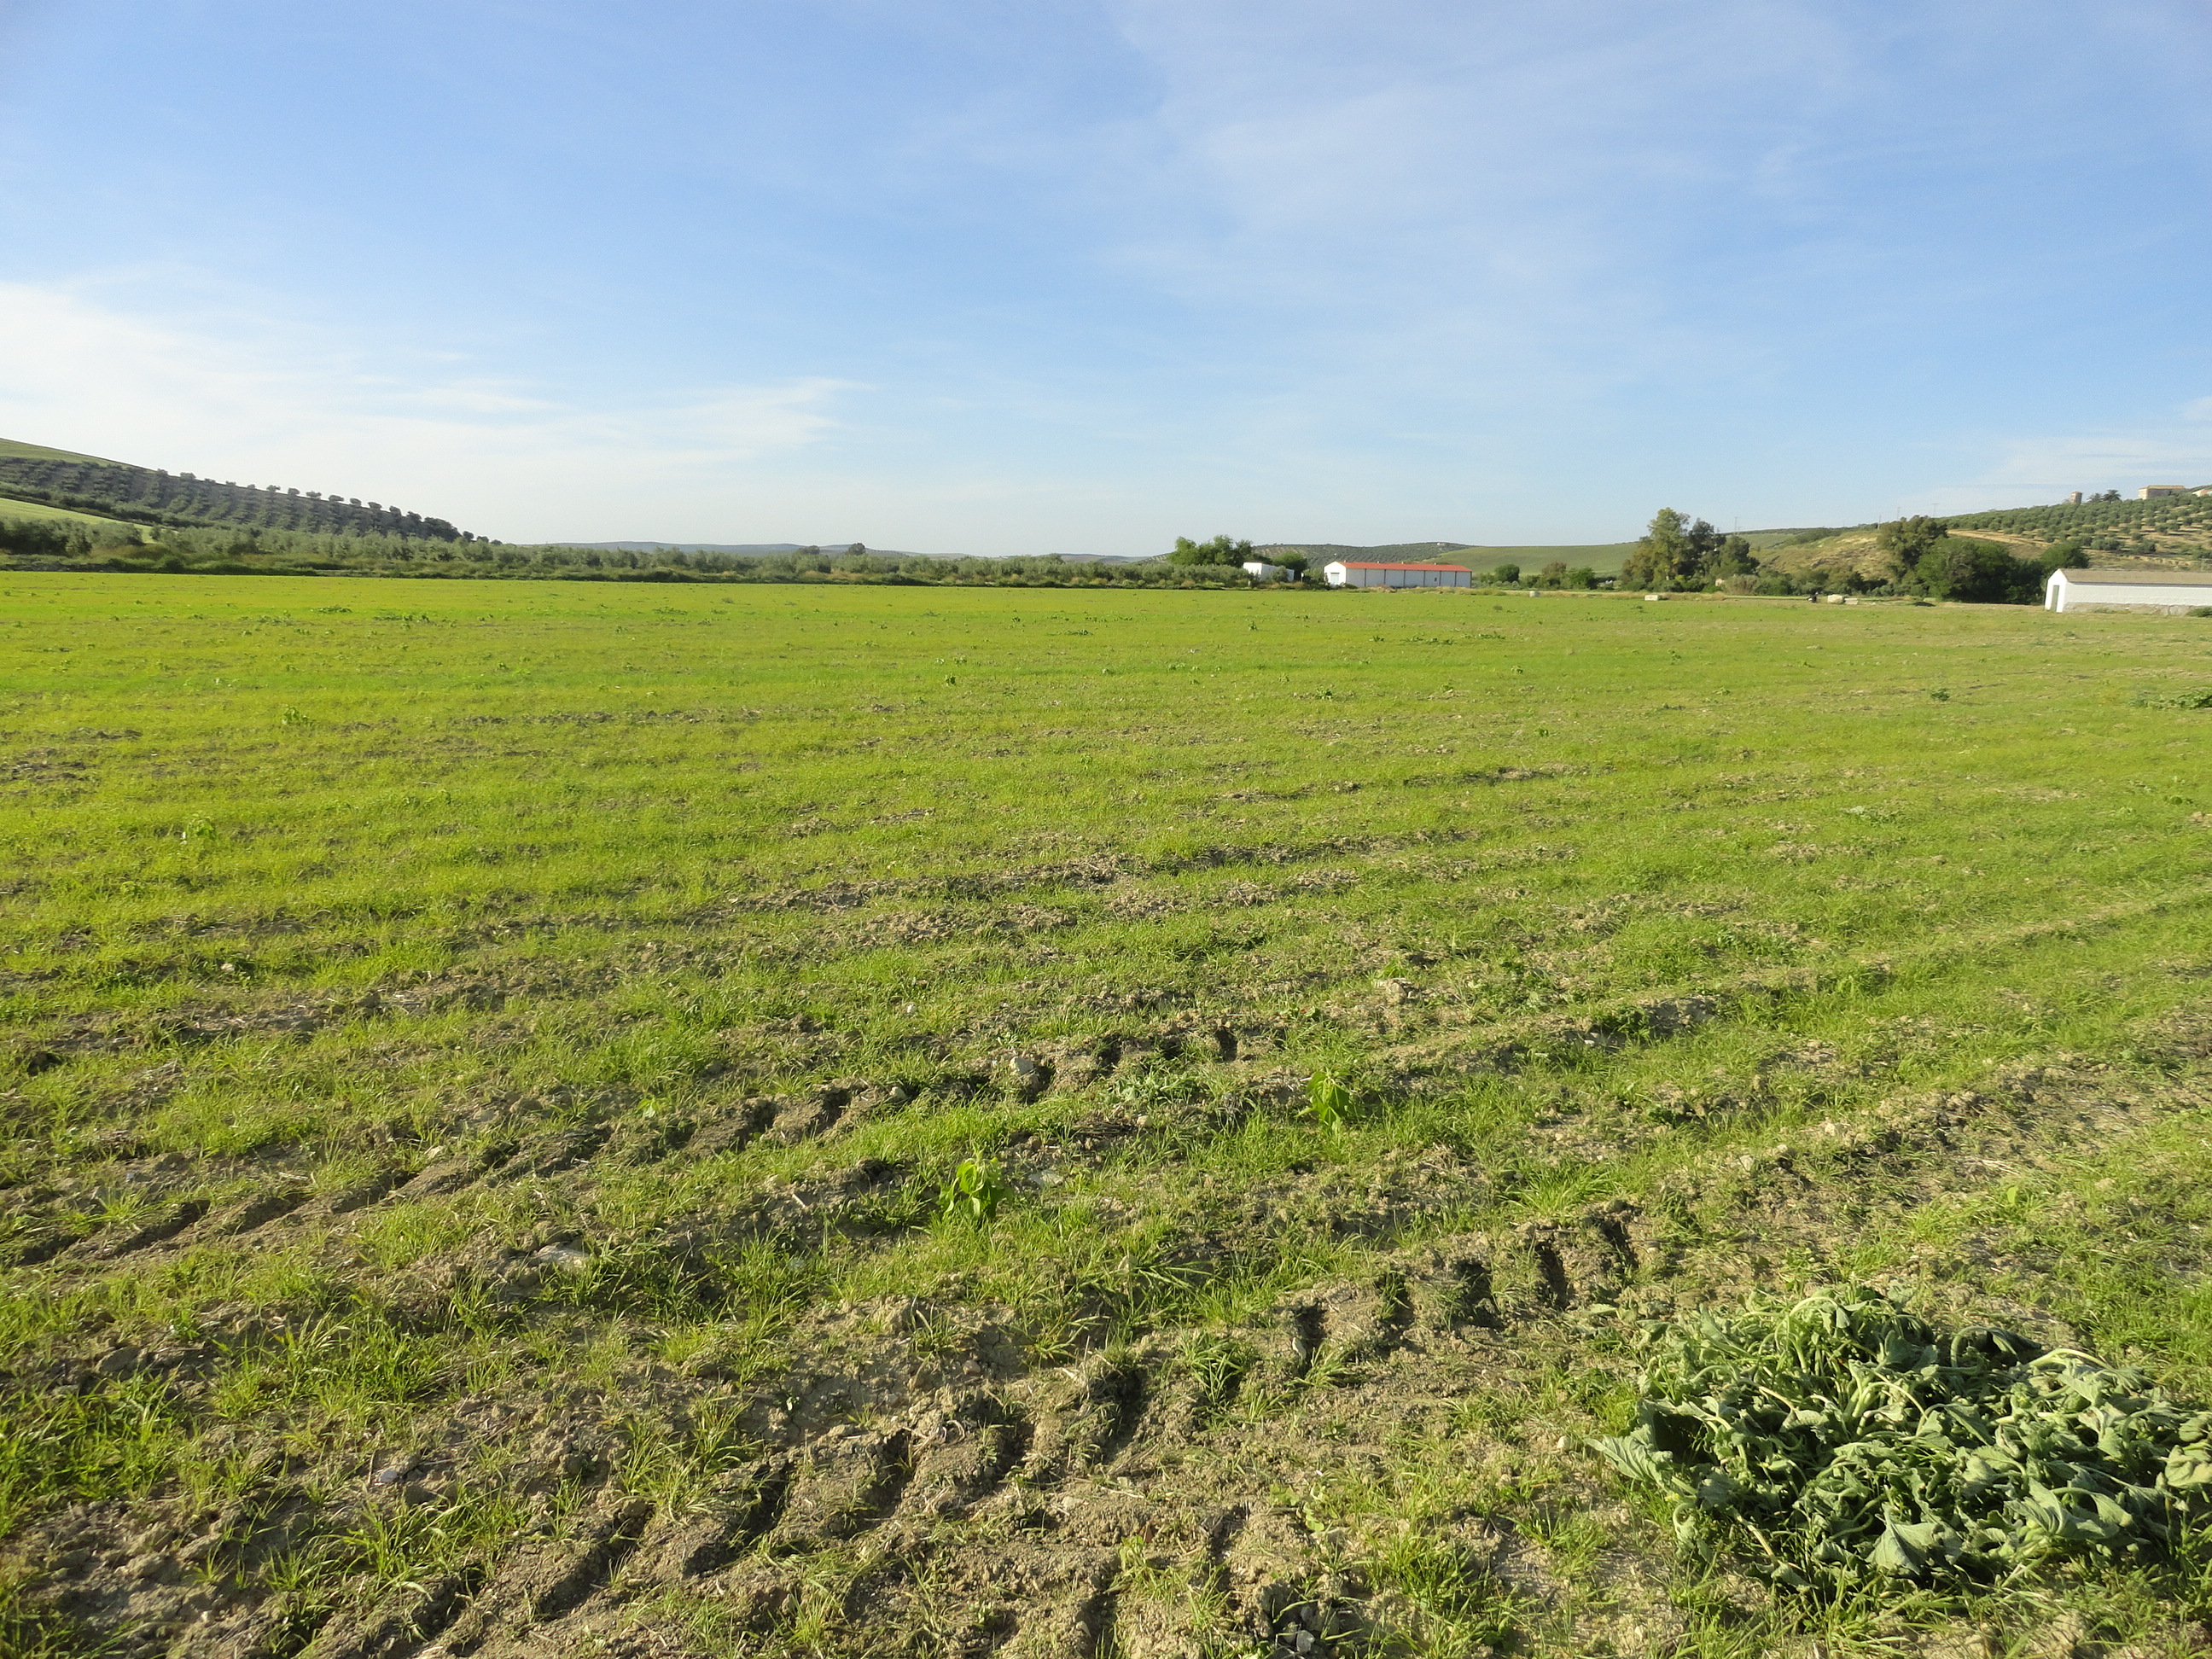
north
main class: Grassland
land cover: Spontaneously vegetated surfaces
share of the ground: 50 - 75 %
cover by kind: herbaceous plants 80 %, unconsolidated bare surface 20 %
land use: Fallow land
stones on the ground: < 10 %
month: April
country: ES
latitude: 37.6942
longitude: -4.5129
